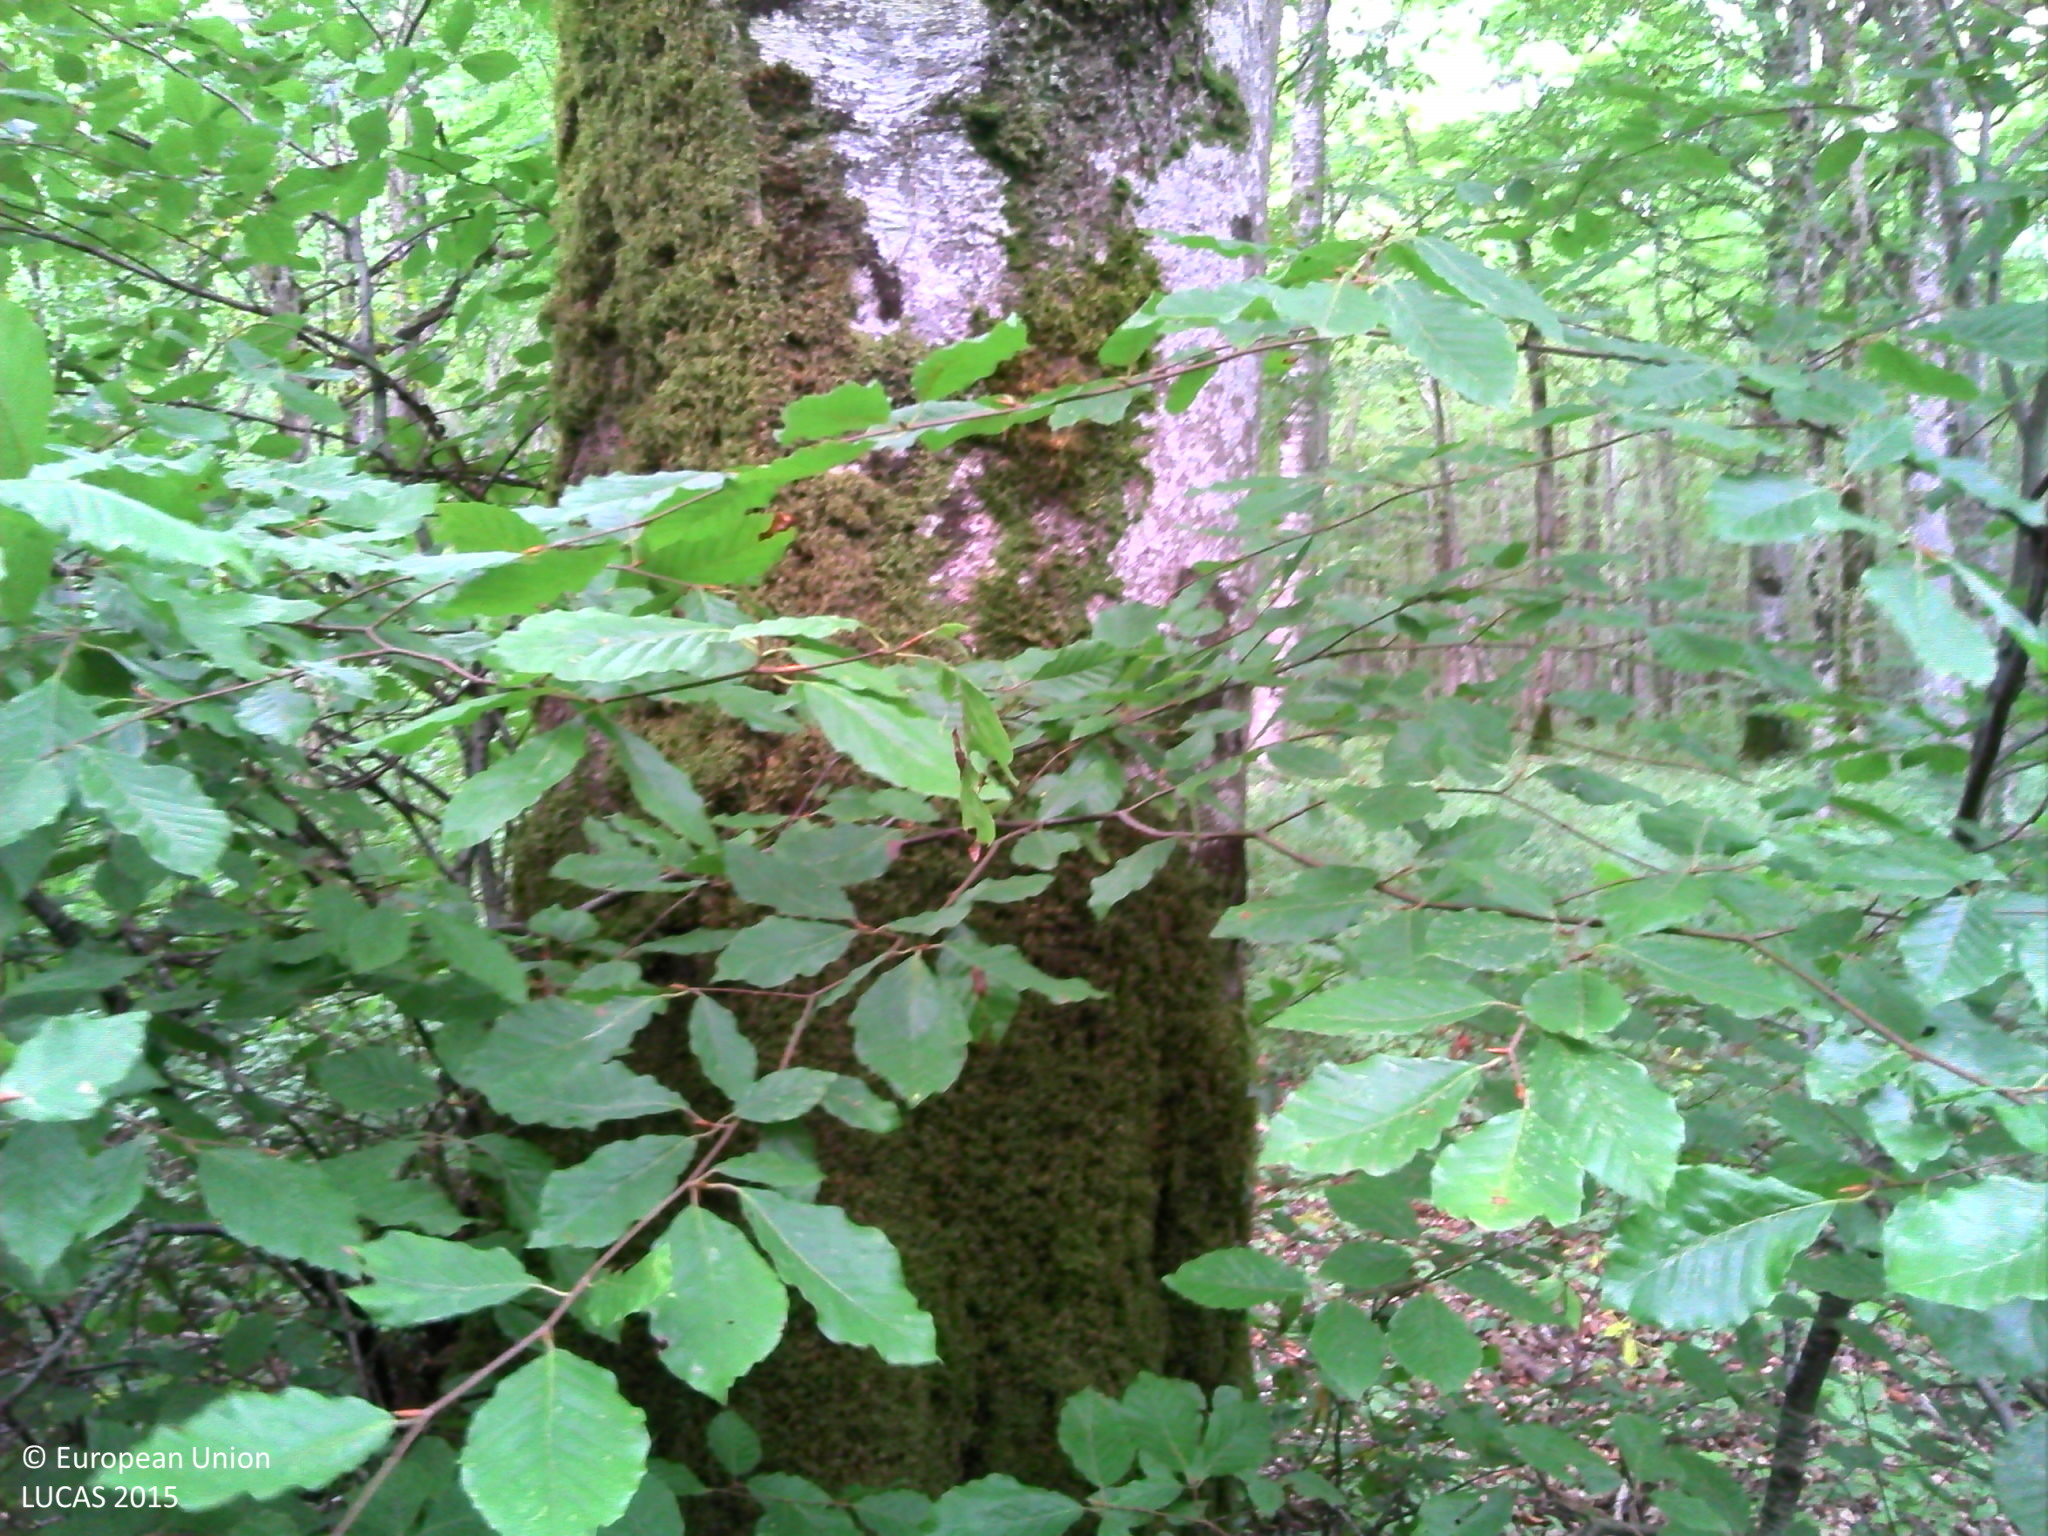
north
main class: Woodland
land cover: Broadleaved woodland
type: mesophytic deciduous forest
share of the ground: > 75 %
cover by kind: broadleaved forest trees 90 %, herbaceous plants 5 %, lichens and mosses 5 %
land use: Forestry
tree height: > 5 m
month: August
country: FR
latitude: 47.7420
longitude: 4.8381
